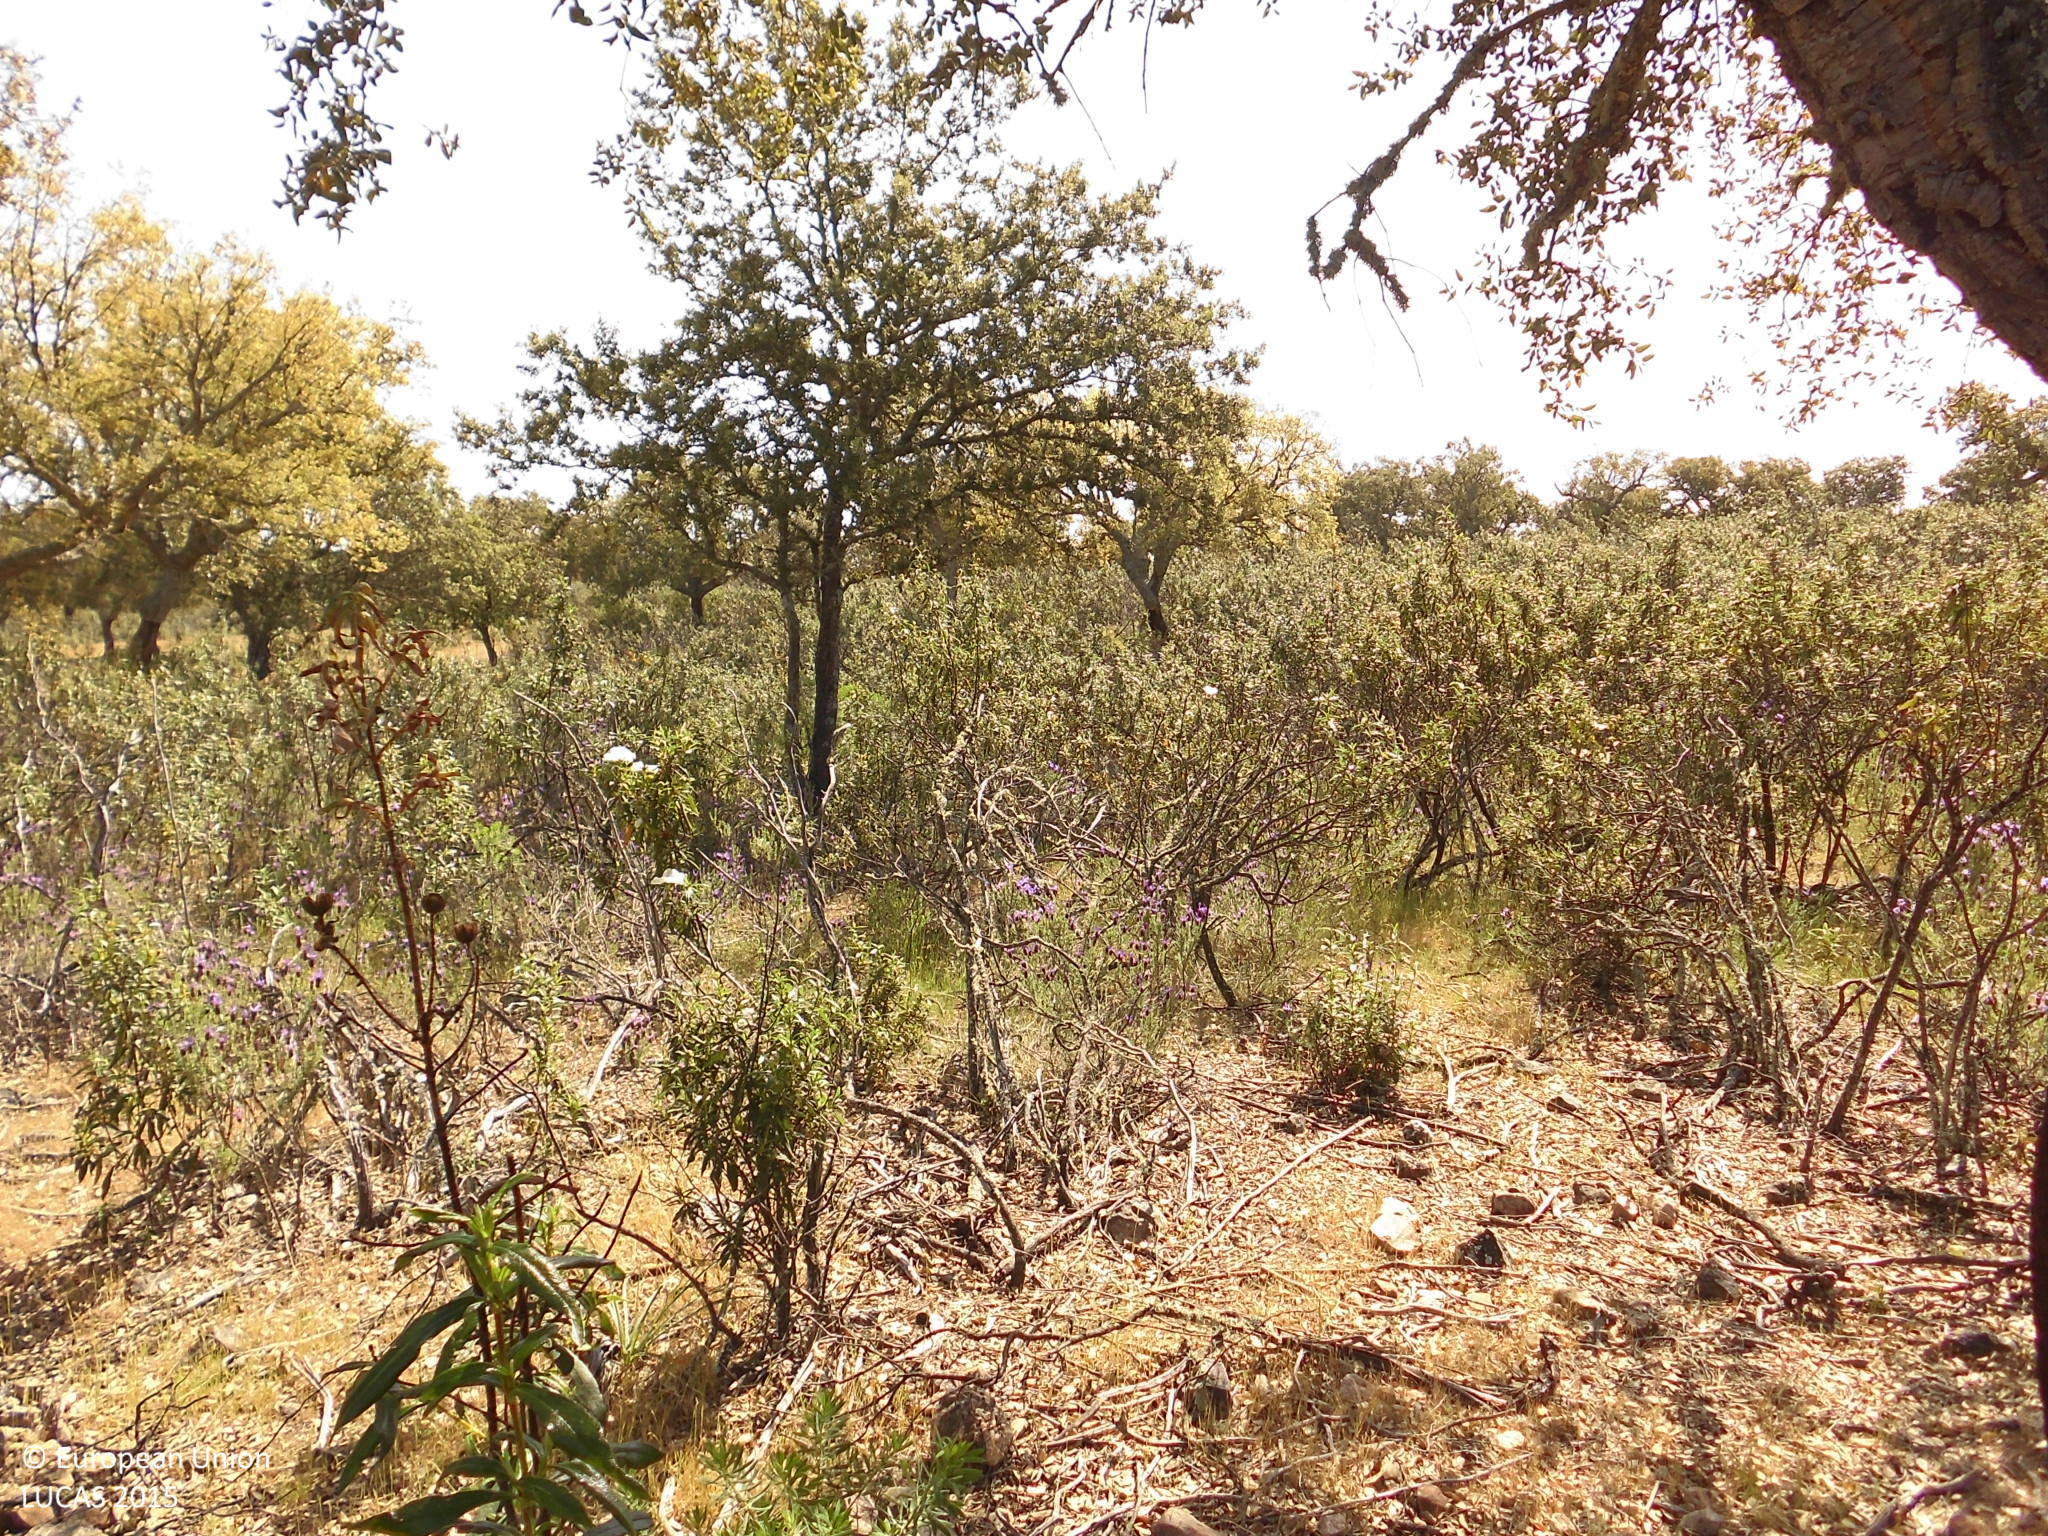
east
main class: Woodland
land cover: Broadleaved woodland
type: broadleaved evergreen forest
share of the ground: 10 - 25 %
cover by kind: herbaceous plants 55 %, shrubs 30 %, broadleaved forest trees 15 %
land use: Forestry
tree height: > 5 m
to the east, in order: Broadleaved woodland; Shrubland without tree cover; Broadleaved woodland; Other structural elements; Broadleaved woodland; Shrubland with sparse tree cover; Broadleaved woodland; Shrubland with sparse tree cover
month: May
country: ES
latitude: 39.4705
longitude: -7.1130
